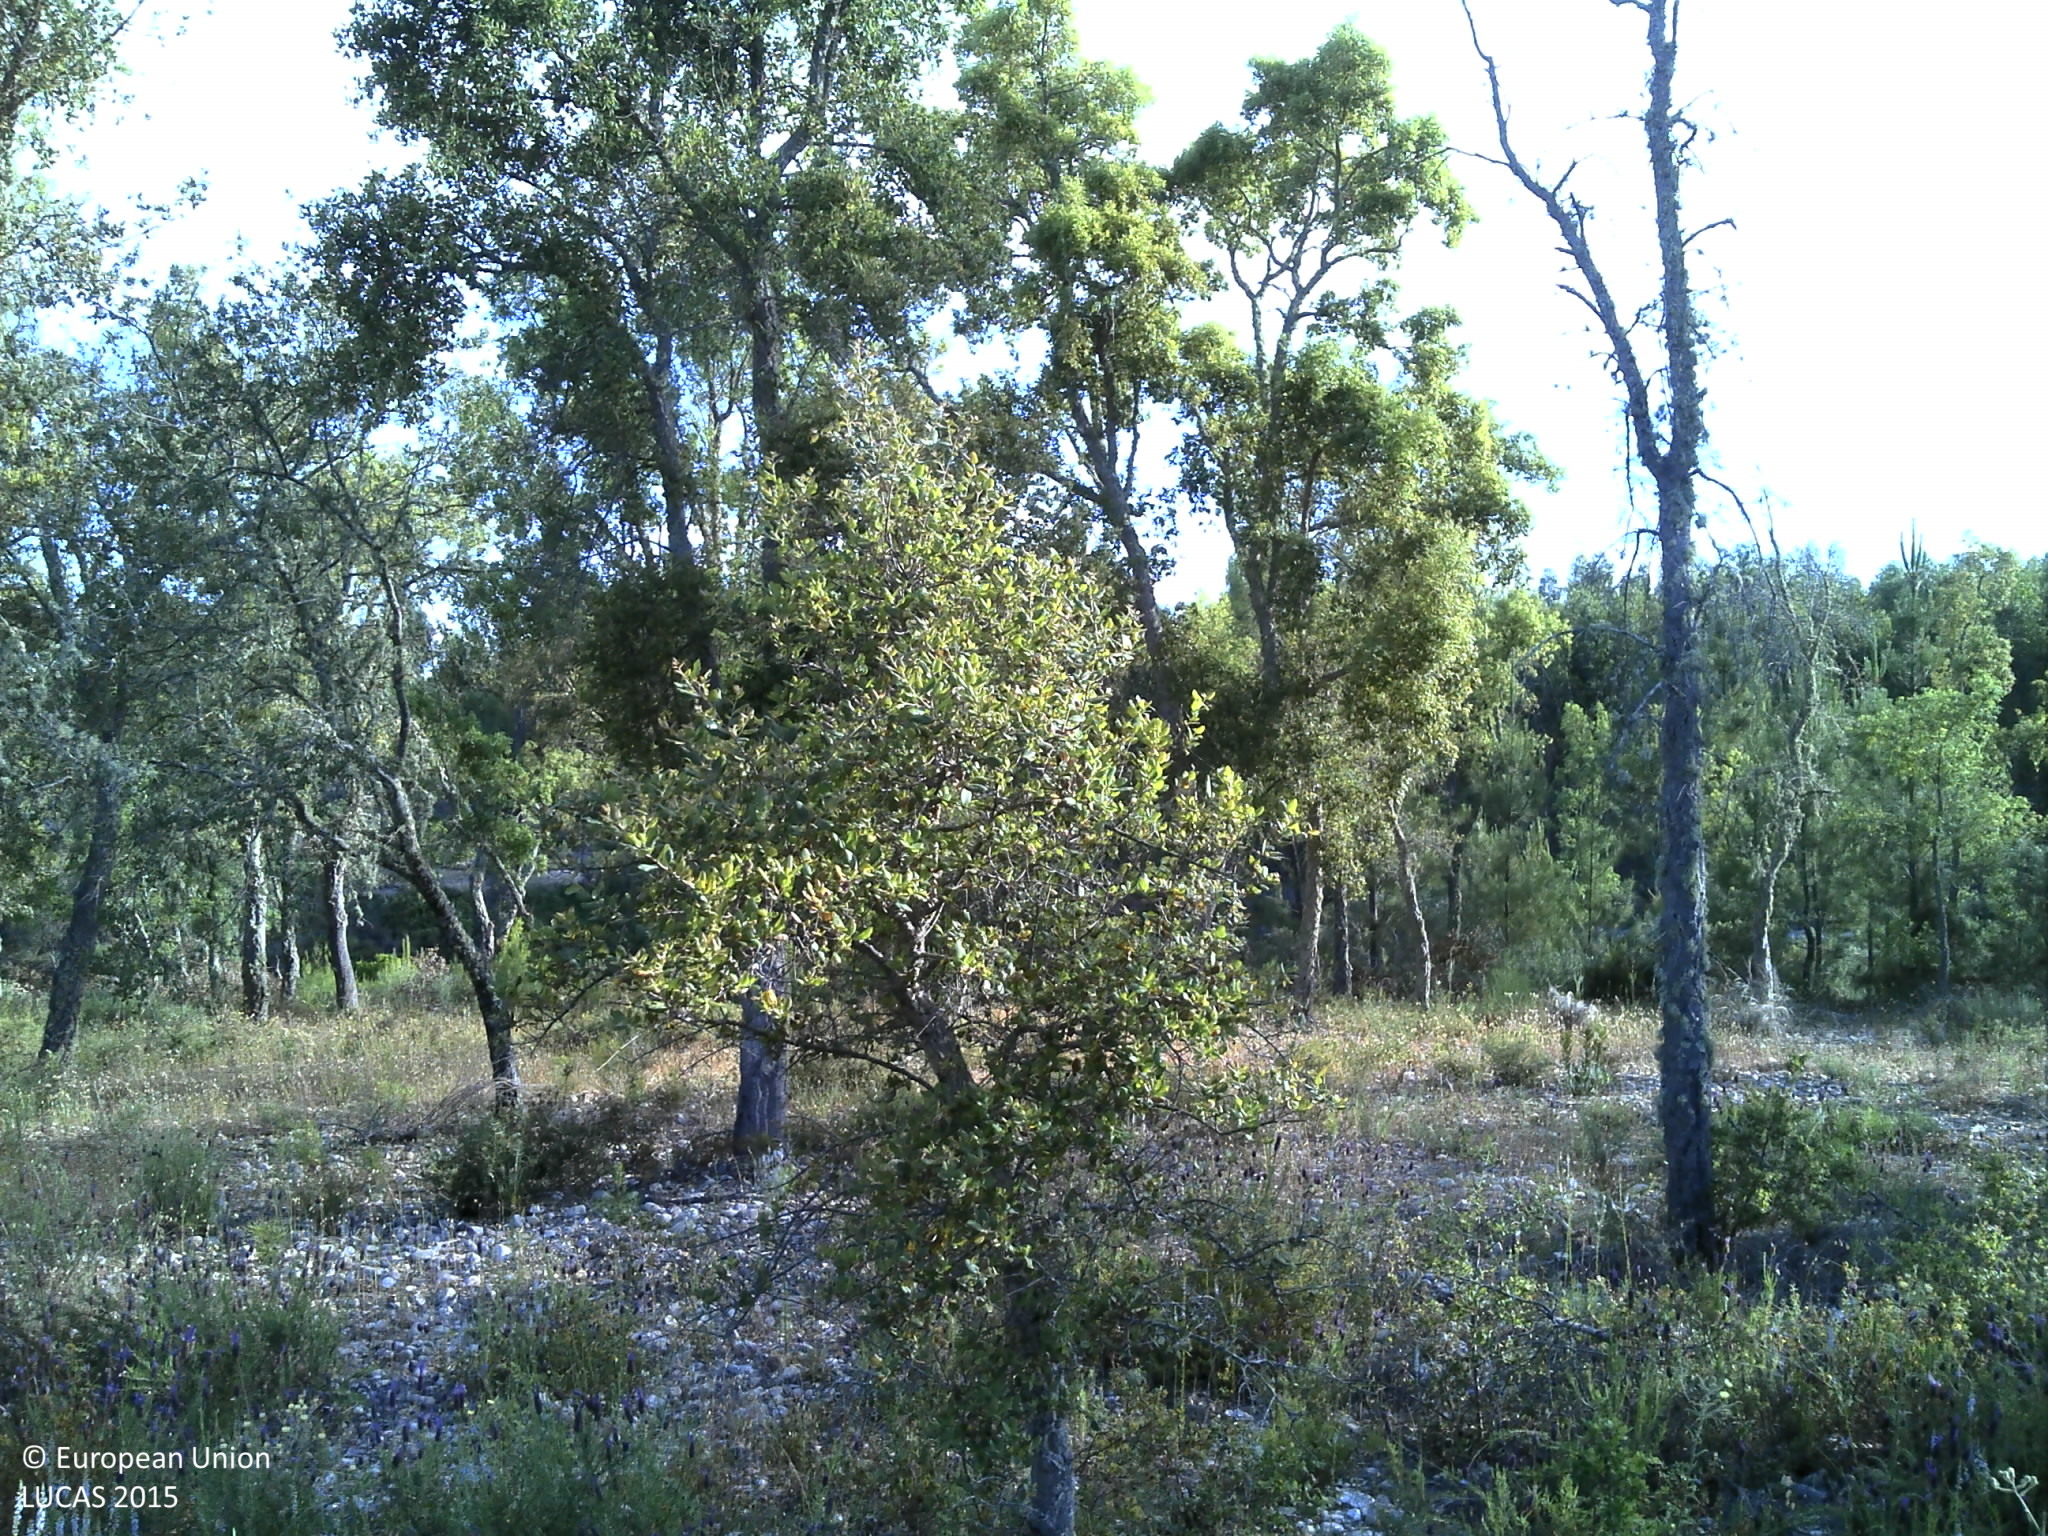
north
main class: Woodland
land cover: Broadleaved woodland
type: broadleaved evergreen forest
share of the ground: 25 - 50 %
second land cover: Shrubland without tree cover
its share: 50 - 75 %
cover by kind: broadleaved forest trees 30 %, shrubs 30 %, herbaceous plants 20 %, unconsolidated bare surface 20 %
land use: Forestry
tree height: > 5 m
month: May
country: PT
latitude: 39.3303
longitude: -7.9788
